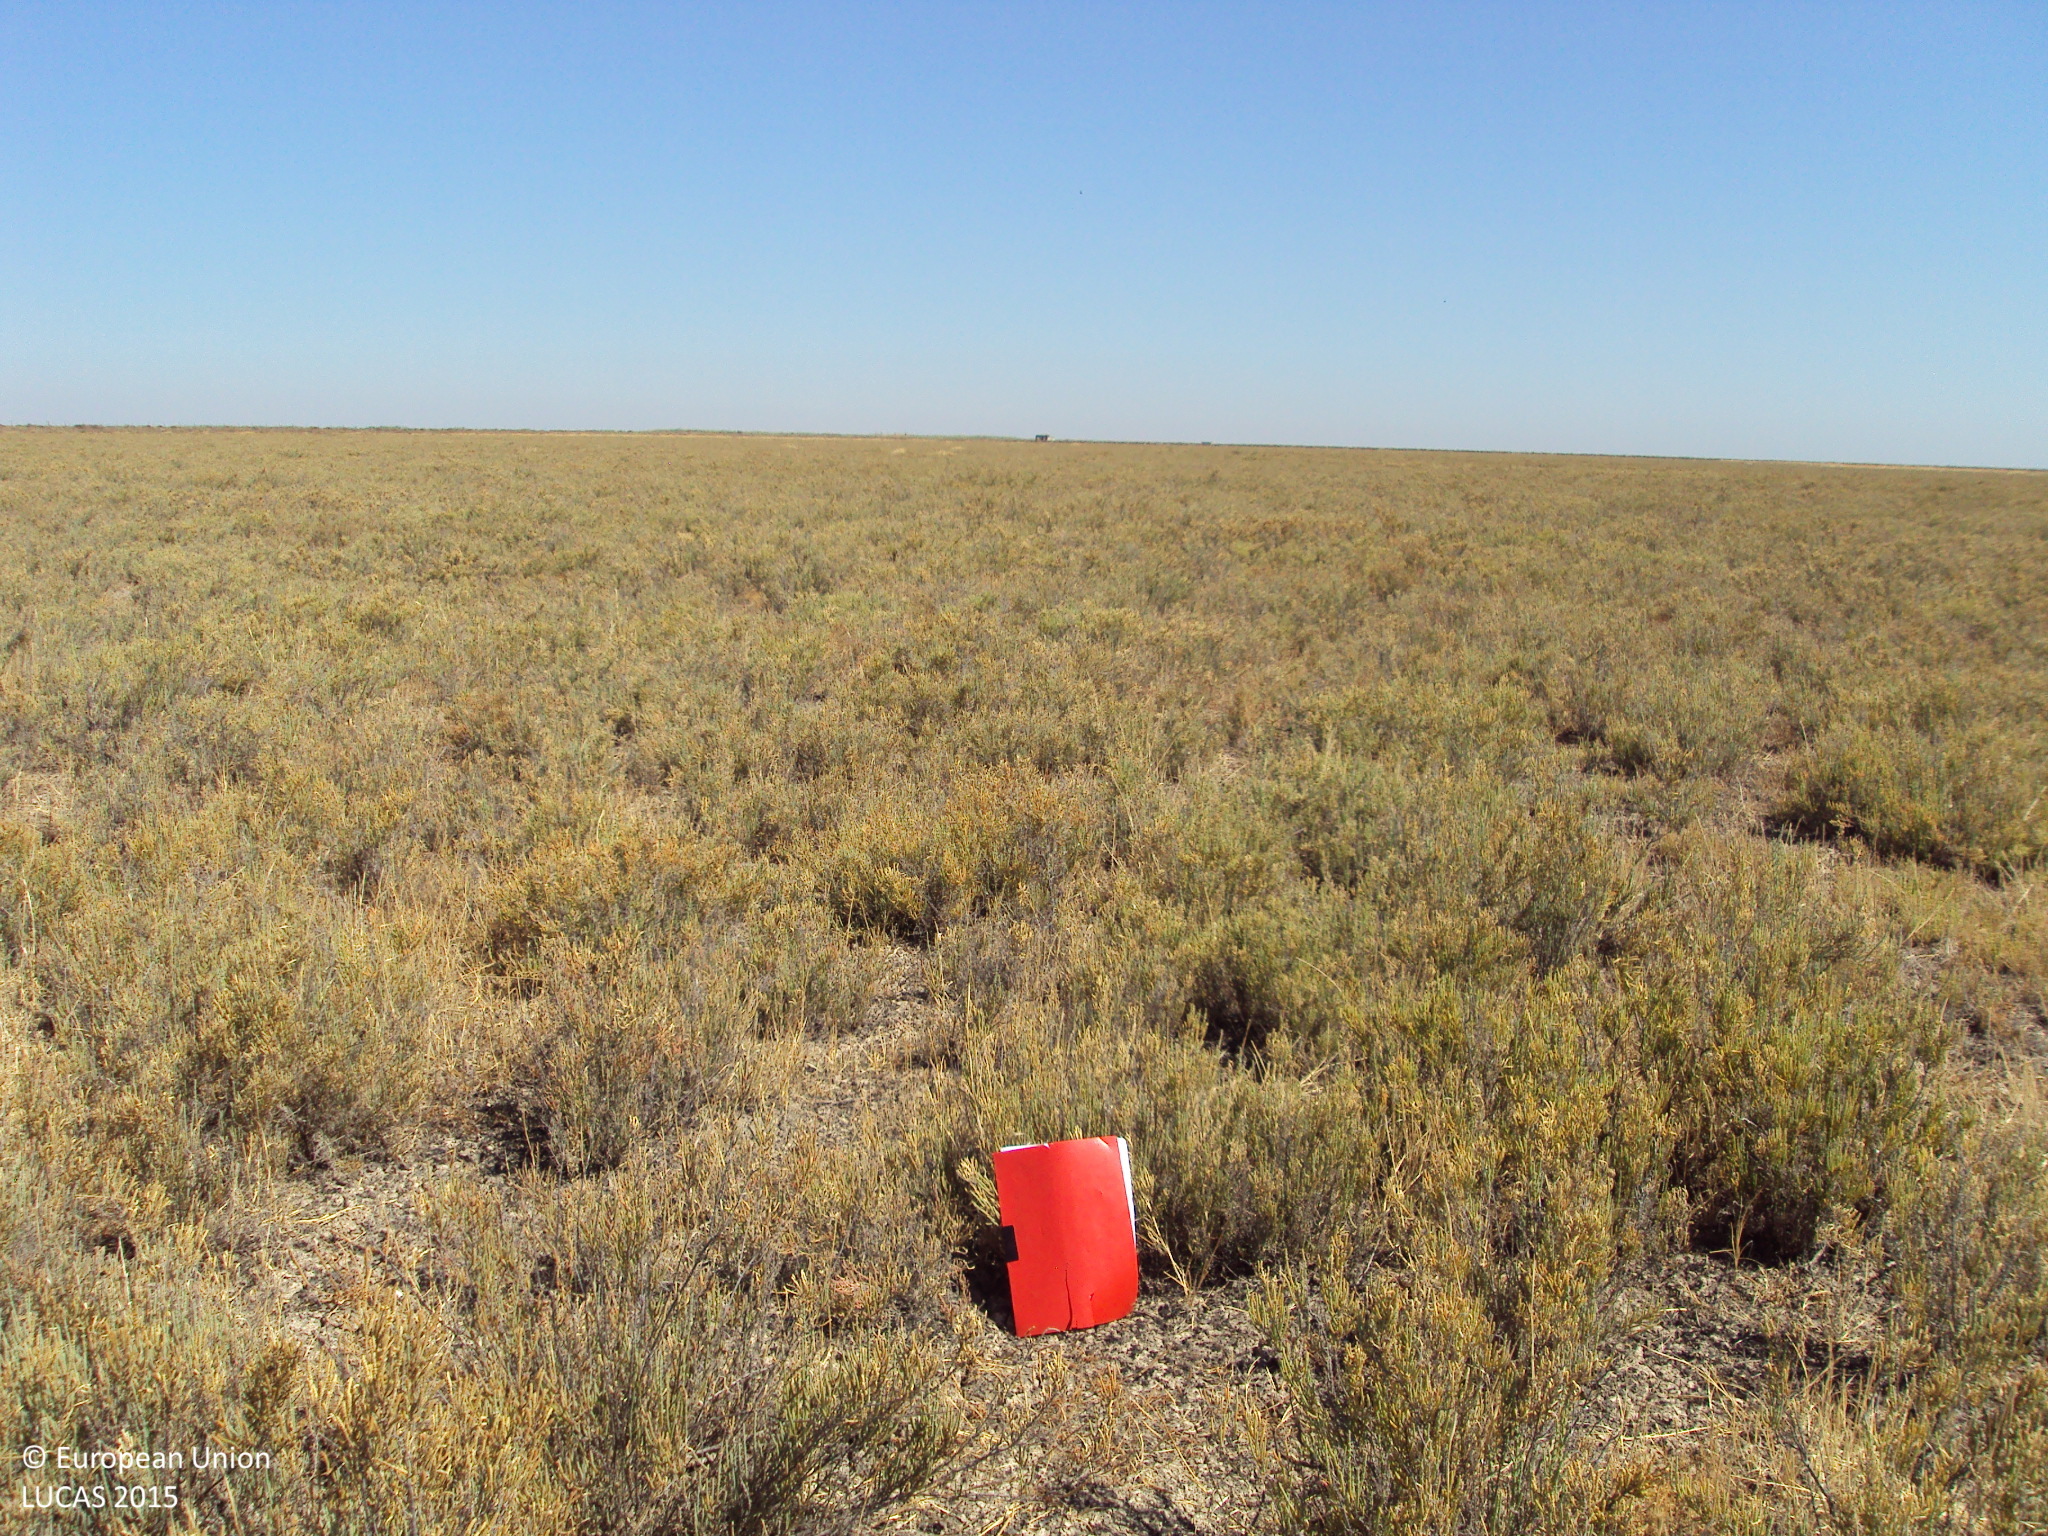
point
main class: Shrubland
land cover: Shrubland without tree cover
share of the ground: > 75 %
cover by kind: shrubs 70 %, consolidated bare surface 20 %, herbaceous plants 10 %
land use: Agriculture (excluding fallow land and kitchen gardens)
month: July
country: ES
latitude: 36.9278
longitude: -6.2638
